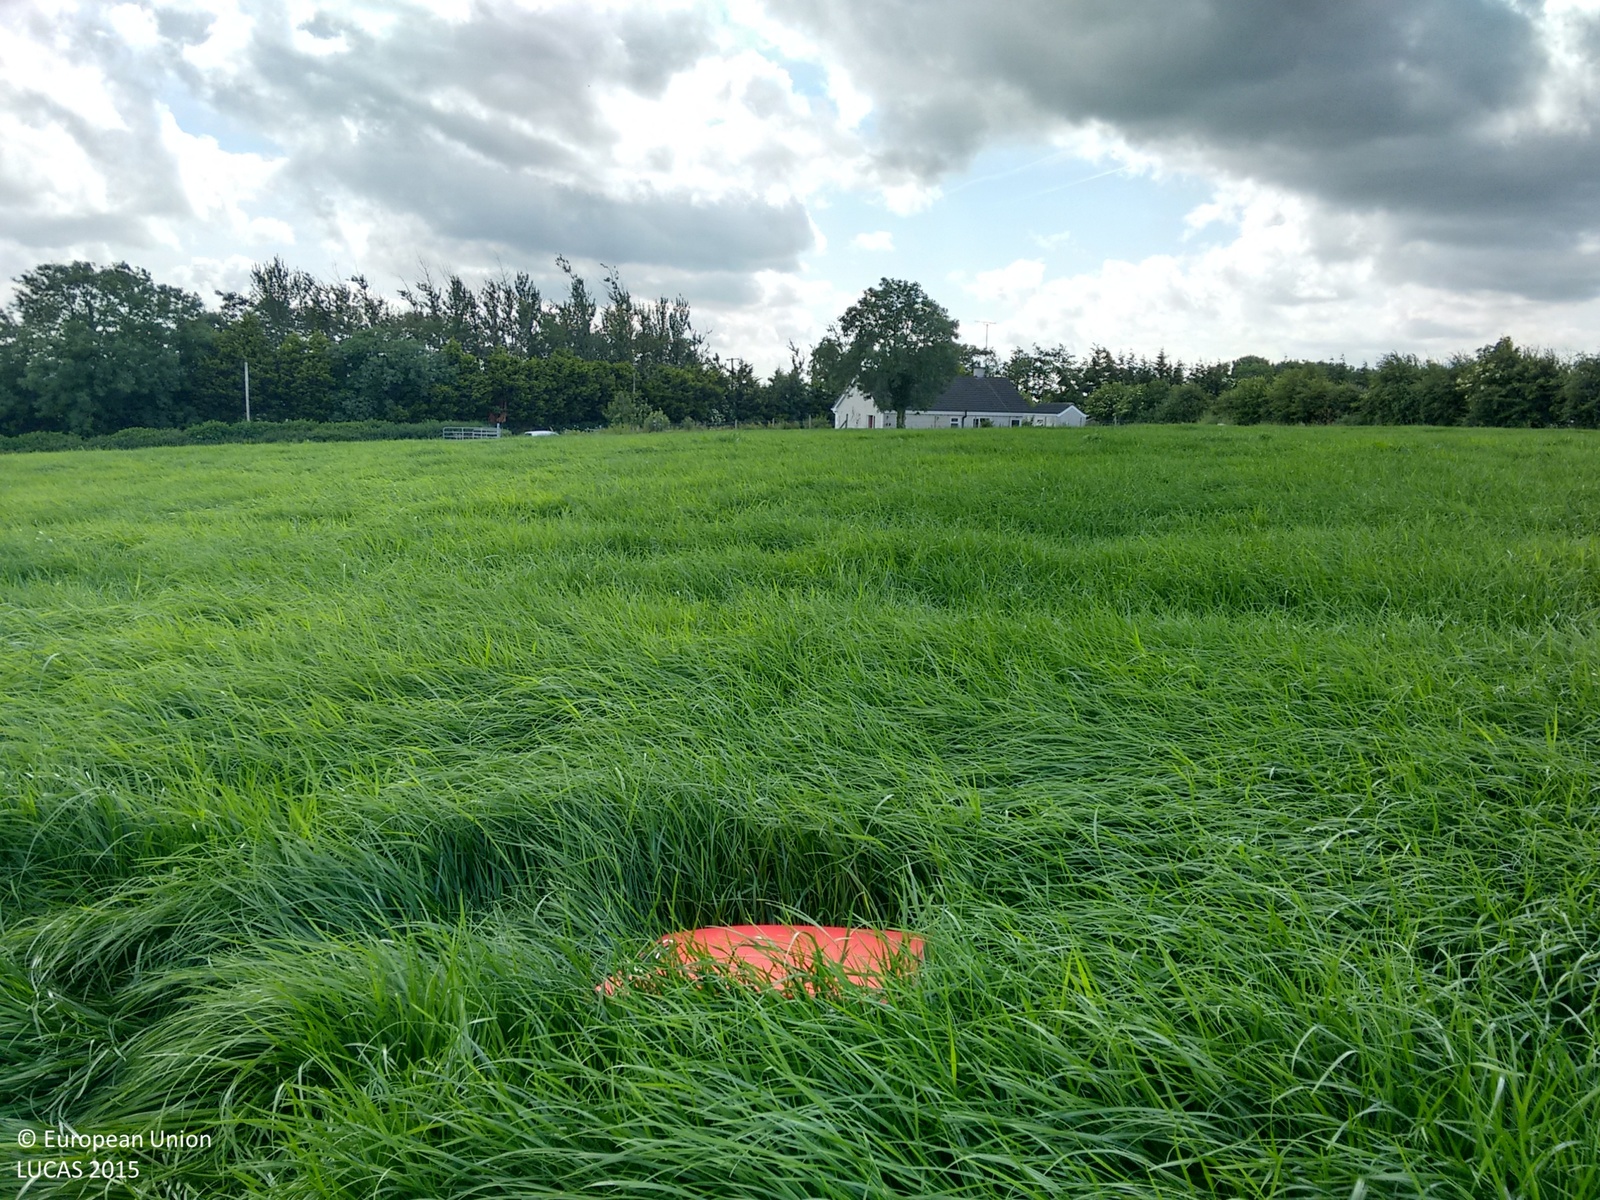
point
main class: Grassland
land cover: Grassland without tree/shrub cover
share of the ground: > 75 %
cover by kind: herbaceous plants 100 %
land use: Agriculture (excluding fallow land and kitchen gardens)
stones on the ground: < 10 %
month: July
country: IE
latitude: 53.7858
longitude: -6.7534
